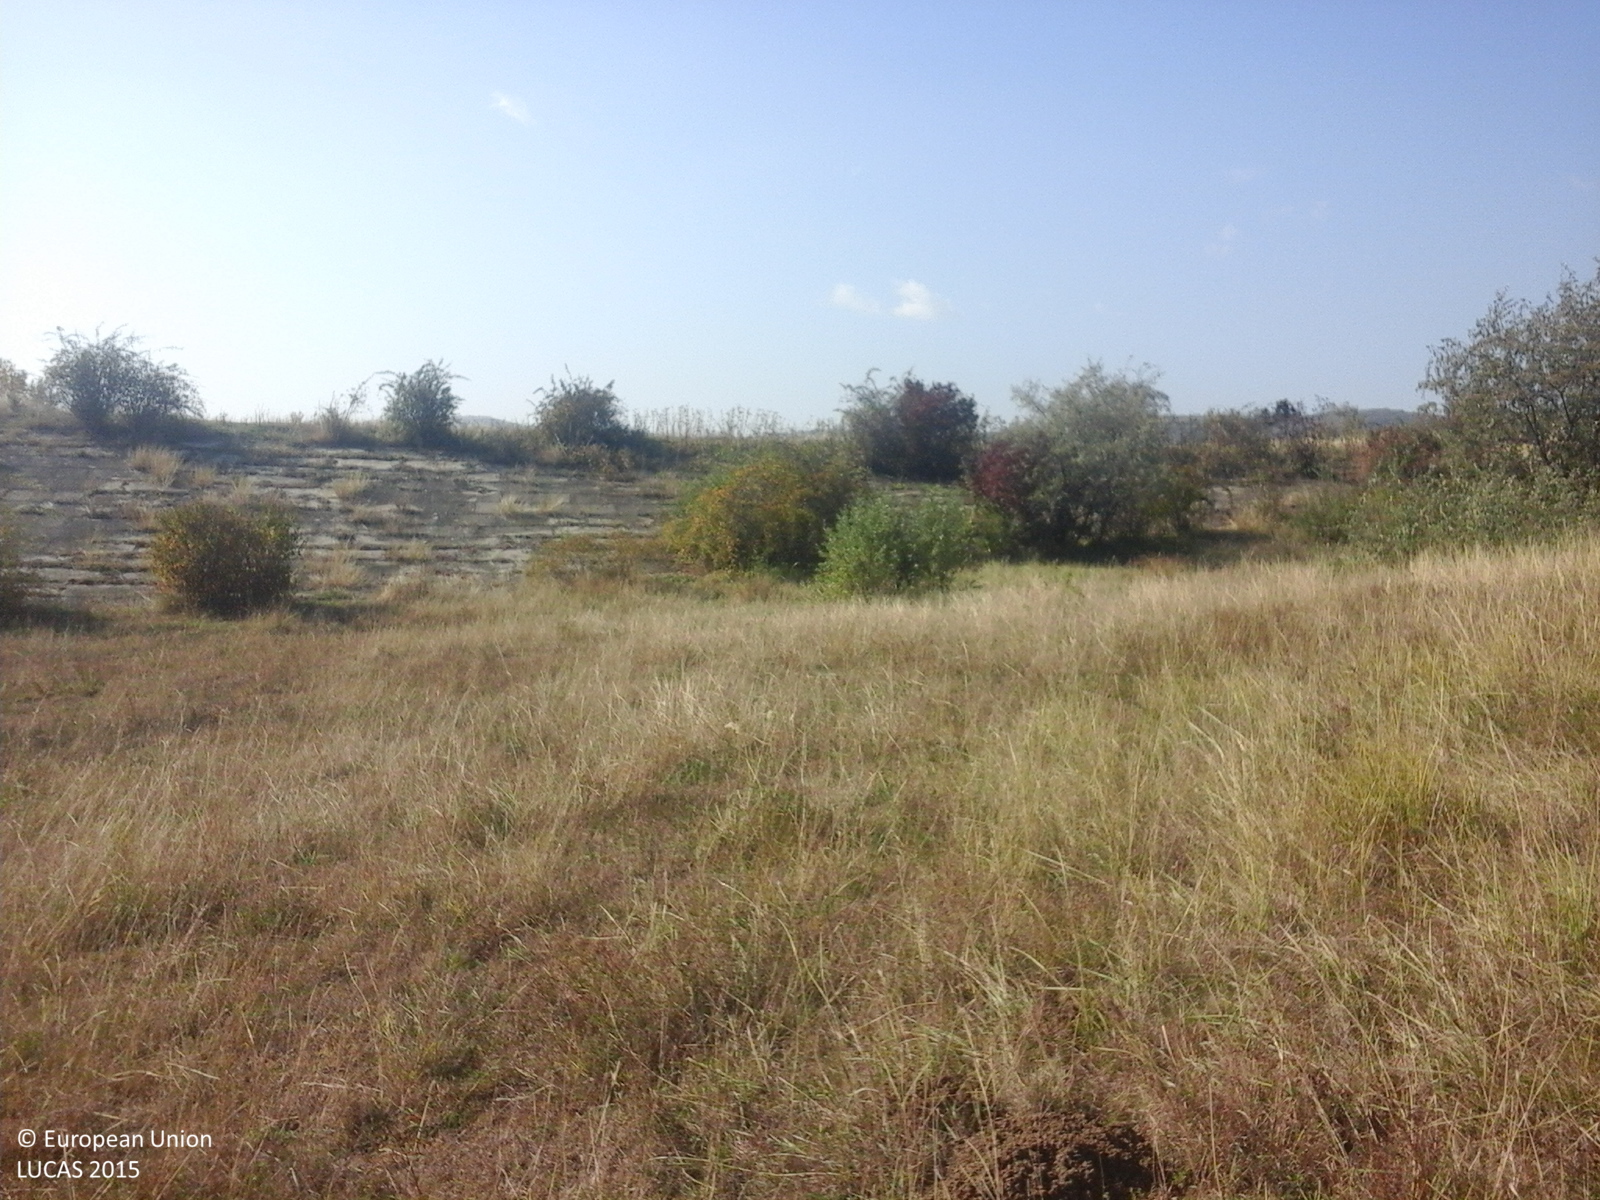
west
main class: Grassland
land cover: Grassland with sparse tree/shrub cover
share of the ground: > 75 %
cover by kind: herbaceous plants 85 %, shrubs 10 %, broadleaved forest trees 5 %
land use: Fallow land
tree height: < 5 m
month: October
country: RO
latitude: 45.0719
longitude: 26.4156
